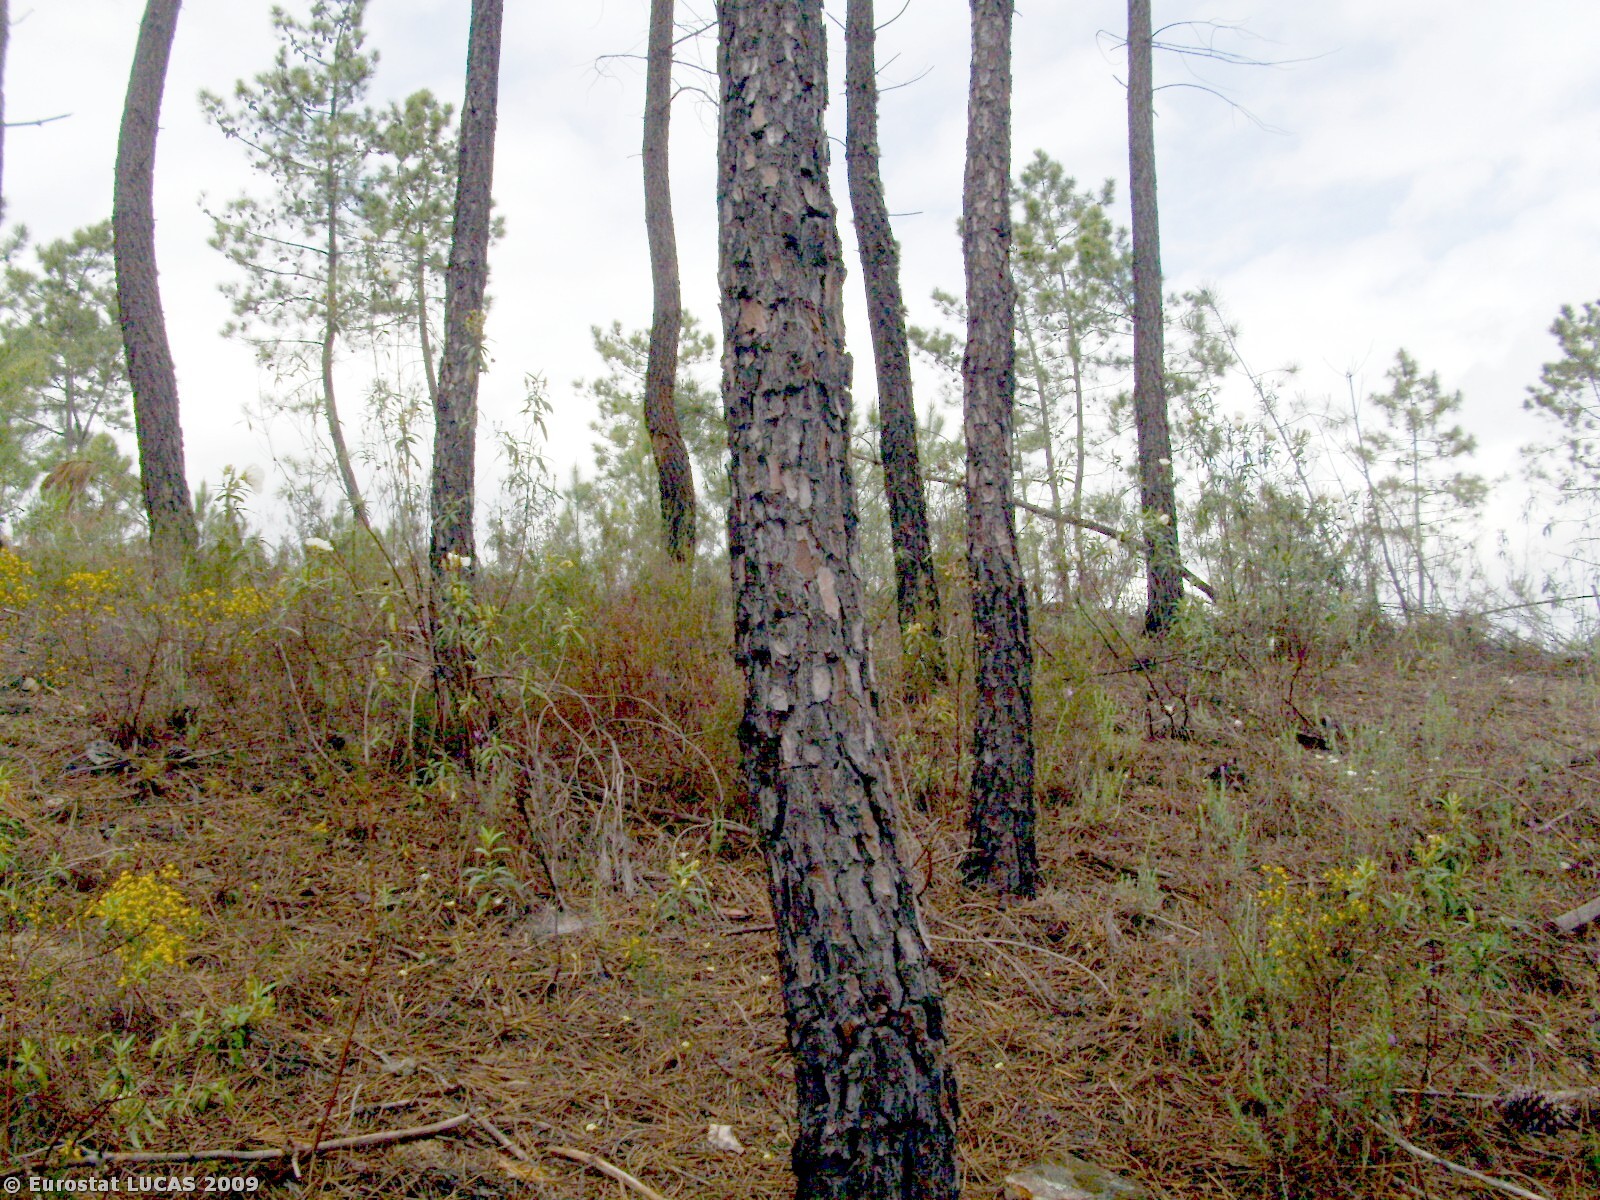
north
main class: Woodland
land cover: Coniferous woodland
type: coniferous forest of the mediterranean region
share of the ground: 50 - 75 %
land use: Forestry
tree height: > 5 m
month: April
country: PT
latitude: 39.8443
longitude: -7.5971
